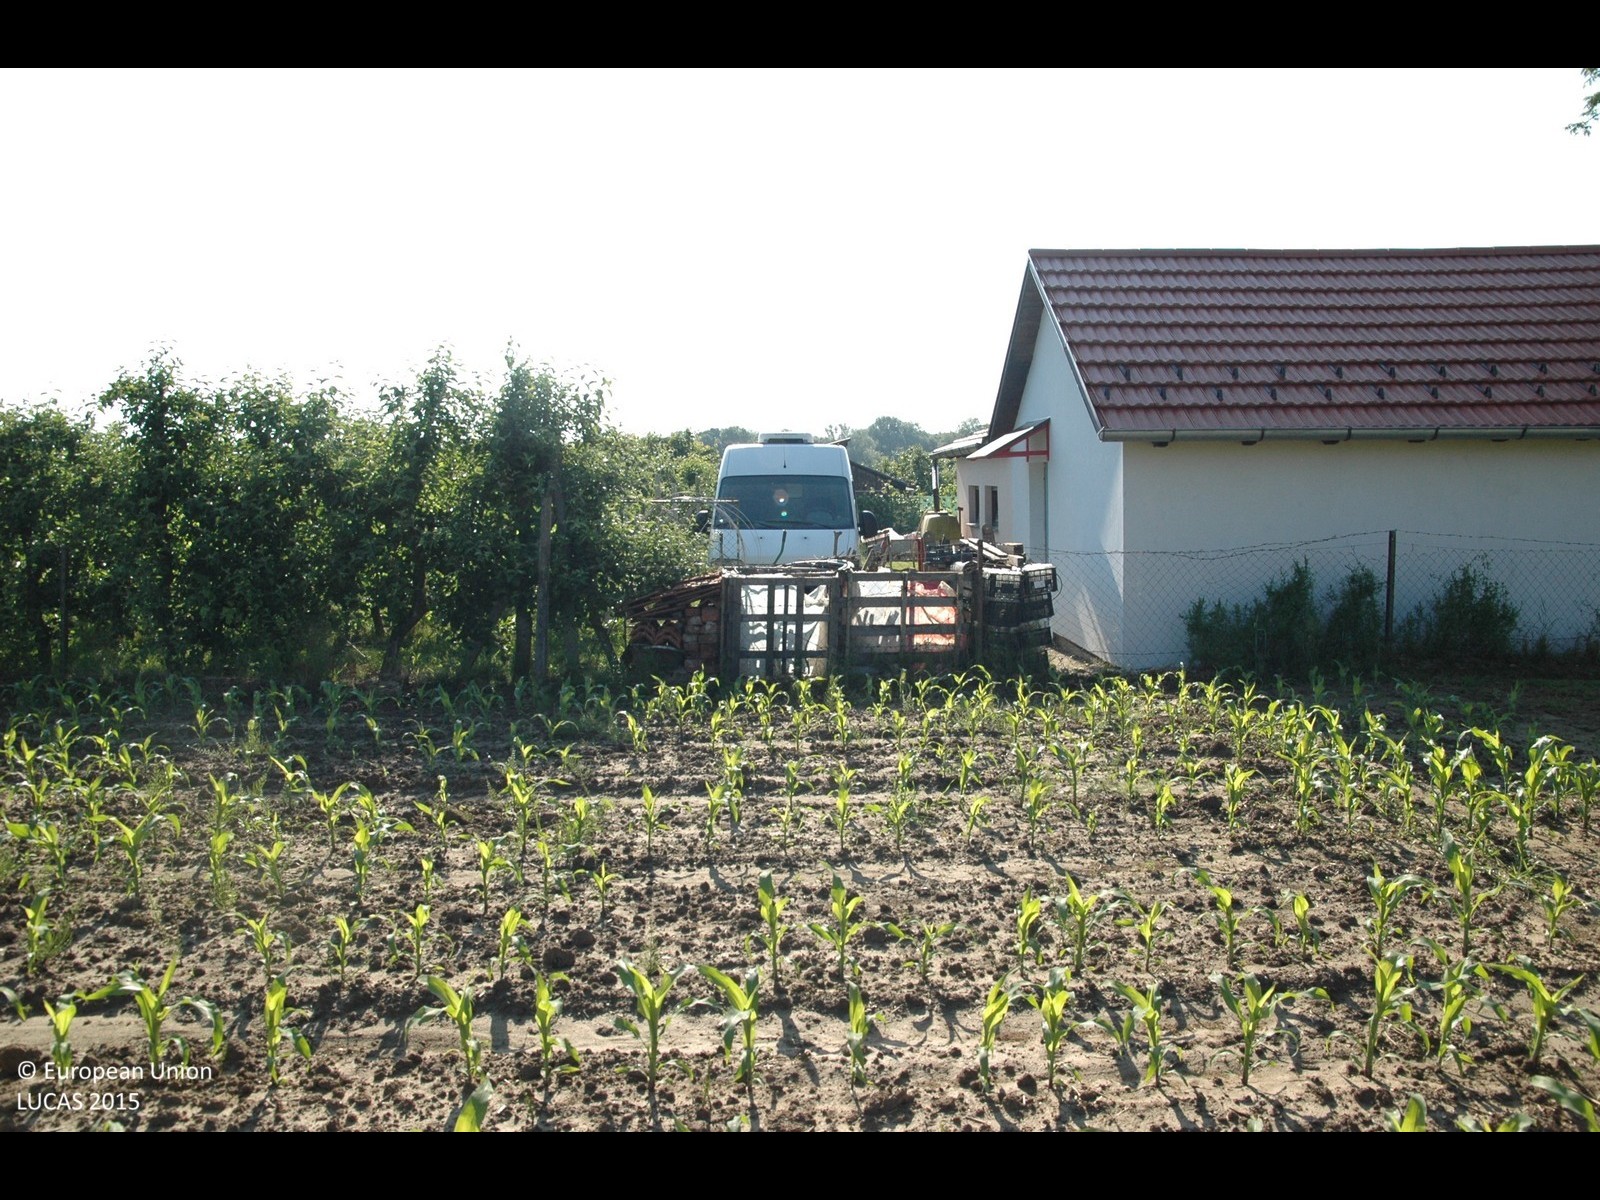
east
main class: Cropland
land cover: Maize
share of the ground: 25 - 50 %
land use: Agriculture (excluding fallow land and kitchen gardens)
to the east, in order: Maize; Artificial constructions in urban areas; Maize; Grass margins; Potatoes; Other fruit trees and berries; Fences; Common wheat; Barley; Maize; Grass margins; Other fresh vegetables; Grass margins; Maize
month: May
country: HR
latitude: 46.4981
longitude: 16.4769
